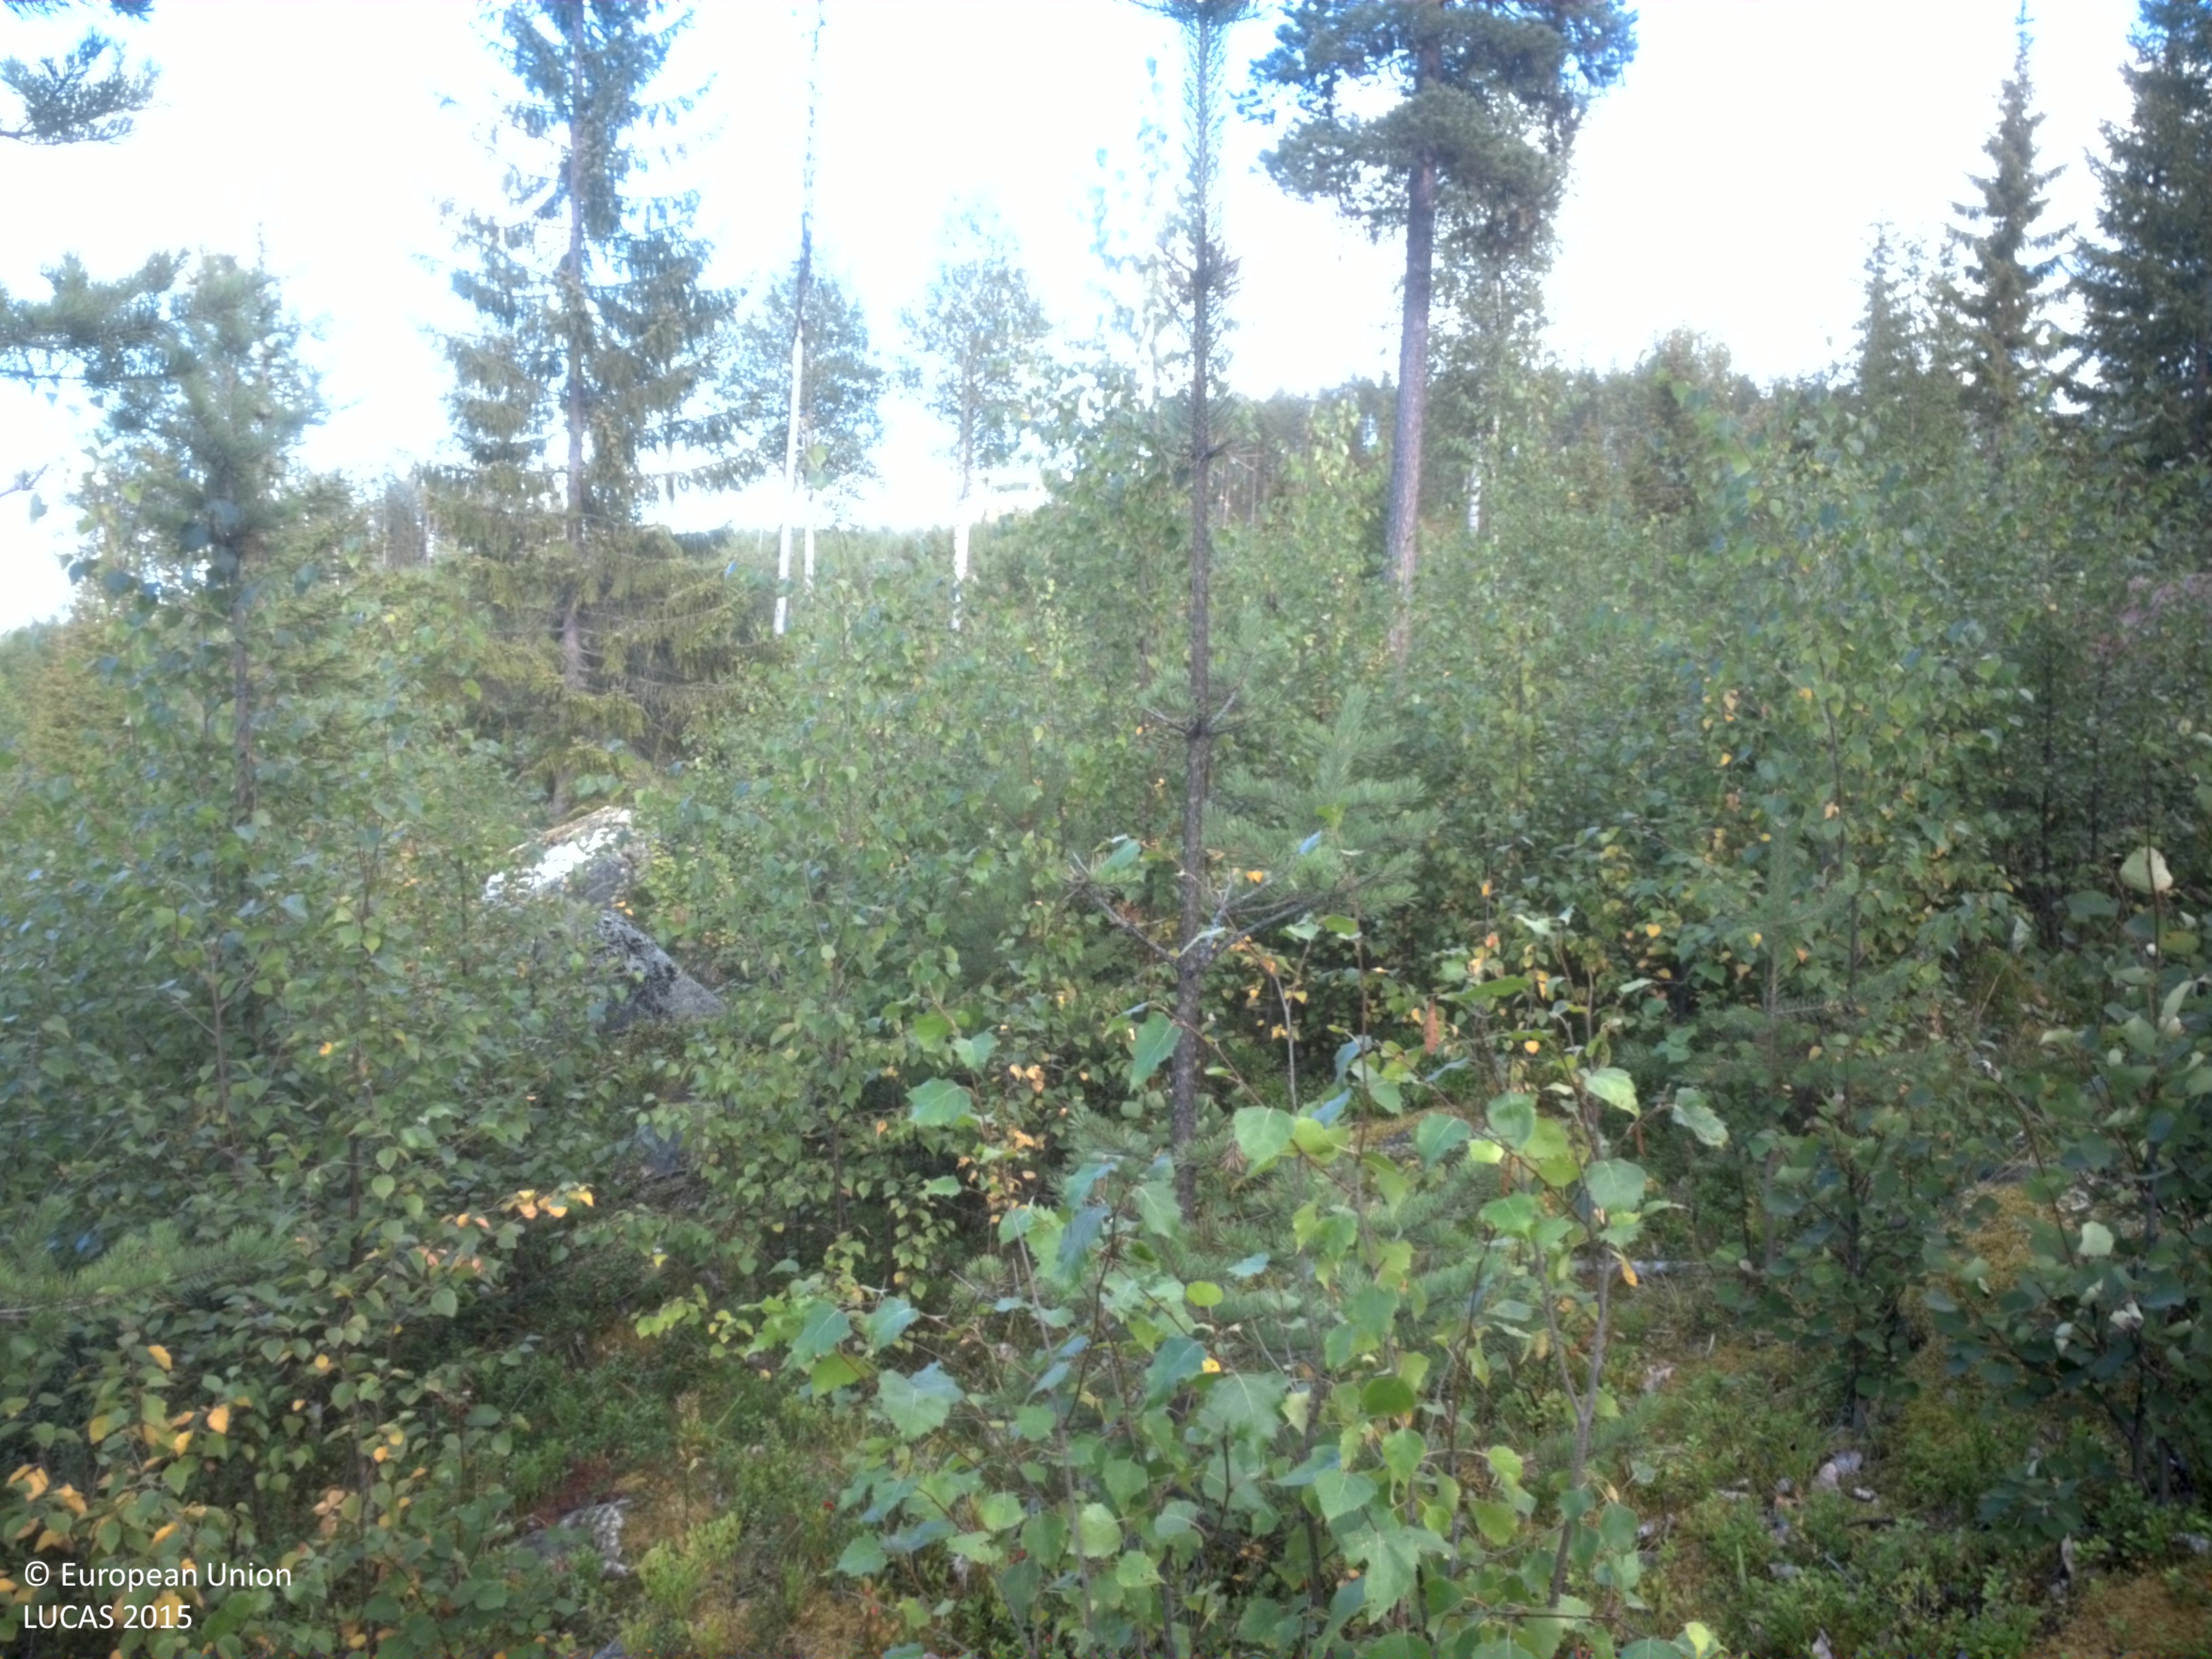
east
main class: Woodland
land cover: Broadleaved woodland
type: boreal forest
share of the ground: 50 - 75 %
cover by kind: broadleaved forest trees 60 %, shrubs 15 %, coniferous forest trees 10 %, lichens and mosses 10 %, herbaceous plants 5 %
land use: Forestry
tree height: > 5 m
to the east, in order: Broadleaved woodland; Pine dominated mixed woodland; Tracks; Spruce dominated mixed woodland; Other mixed woodland; Pine dominated mixed woodland
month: September
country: SE
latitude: 64.4309
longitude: 19.0452
